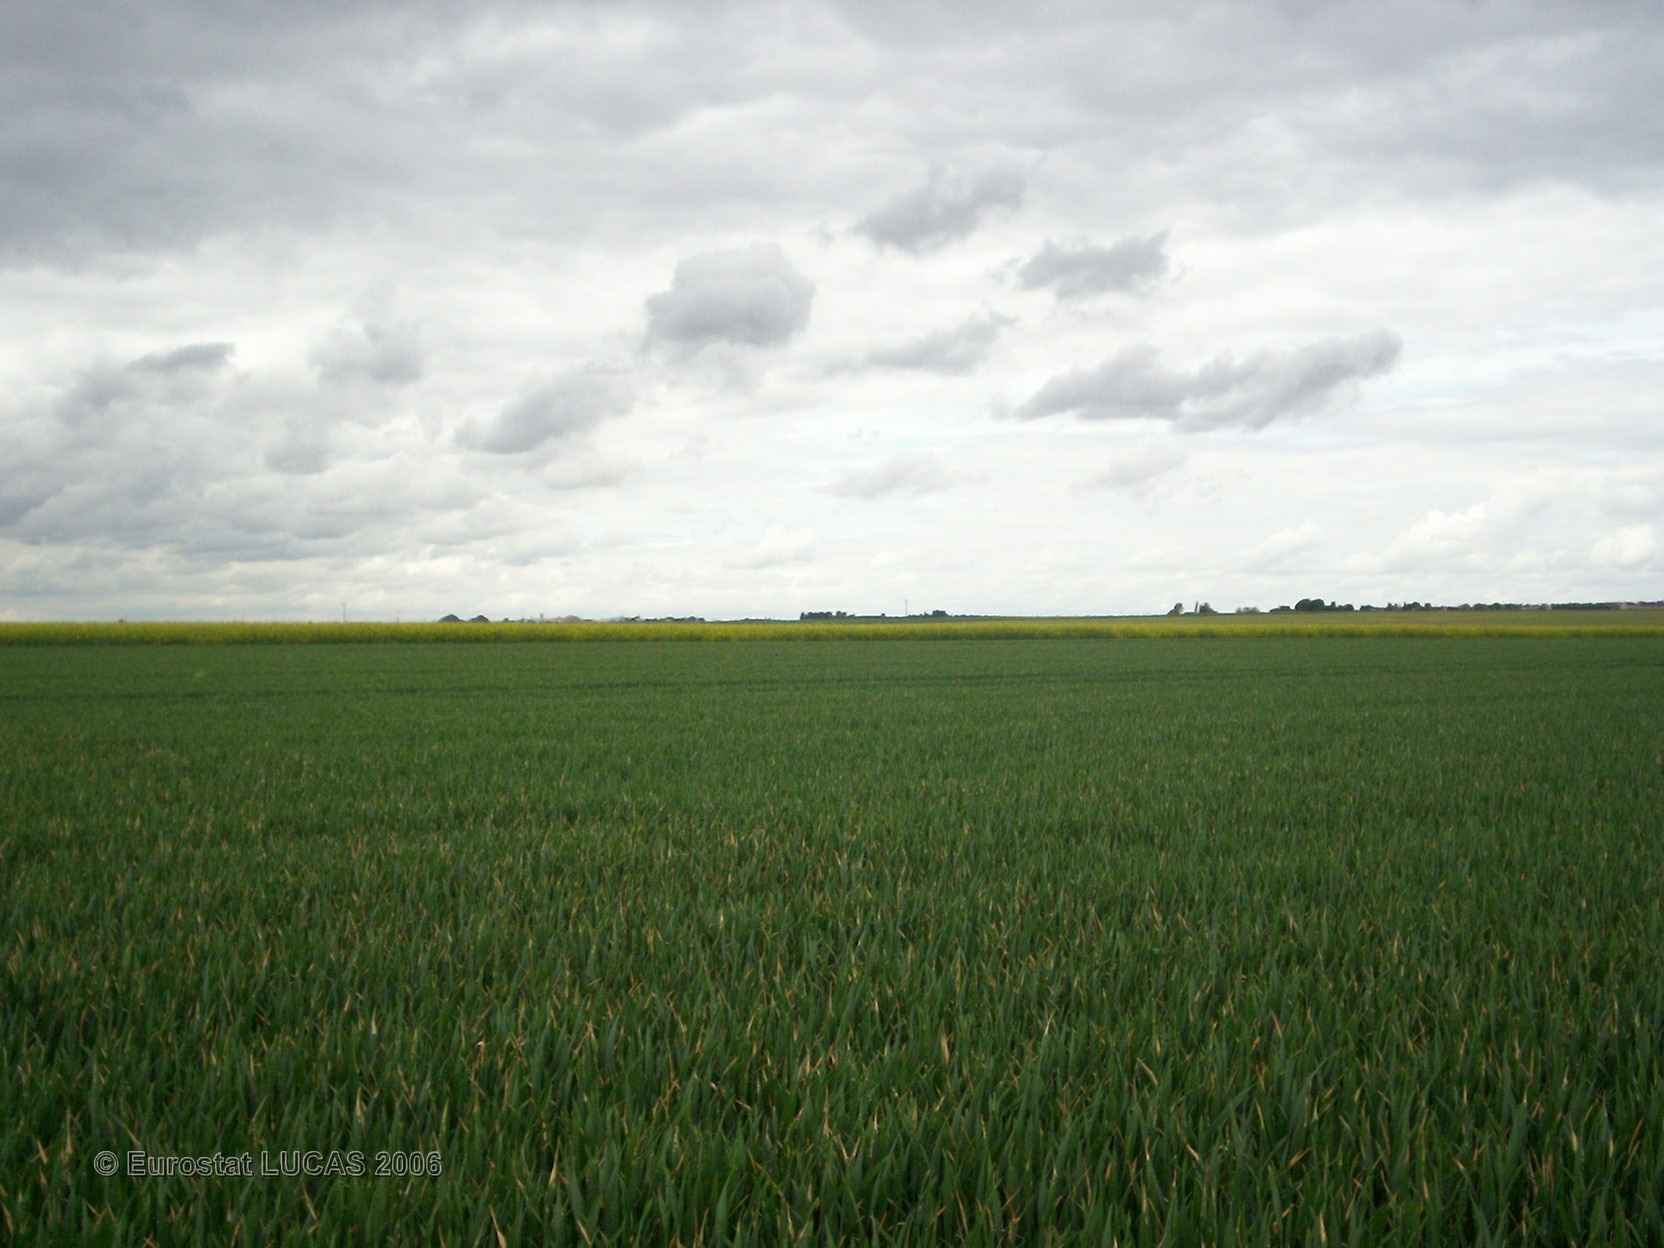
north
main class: Cropland
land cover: Common wheat
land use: Agriculture (excluding fallow land and kitchen gardens)
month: May
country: FR
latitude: 49.0881
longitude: 2.7736
